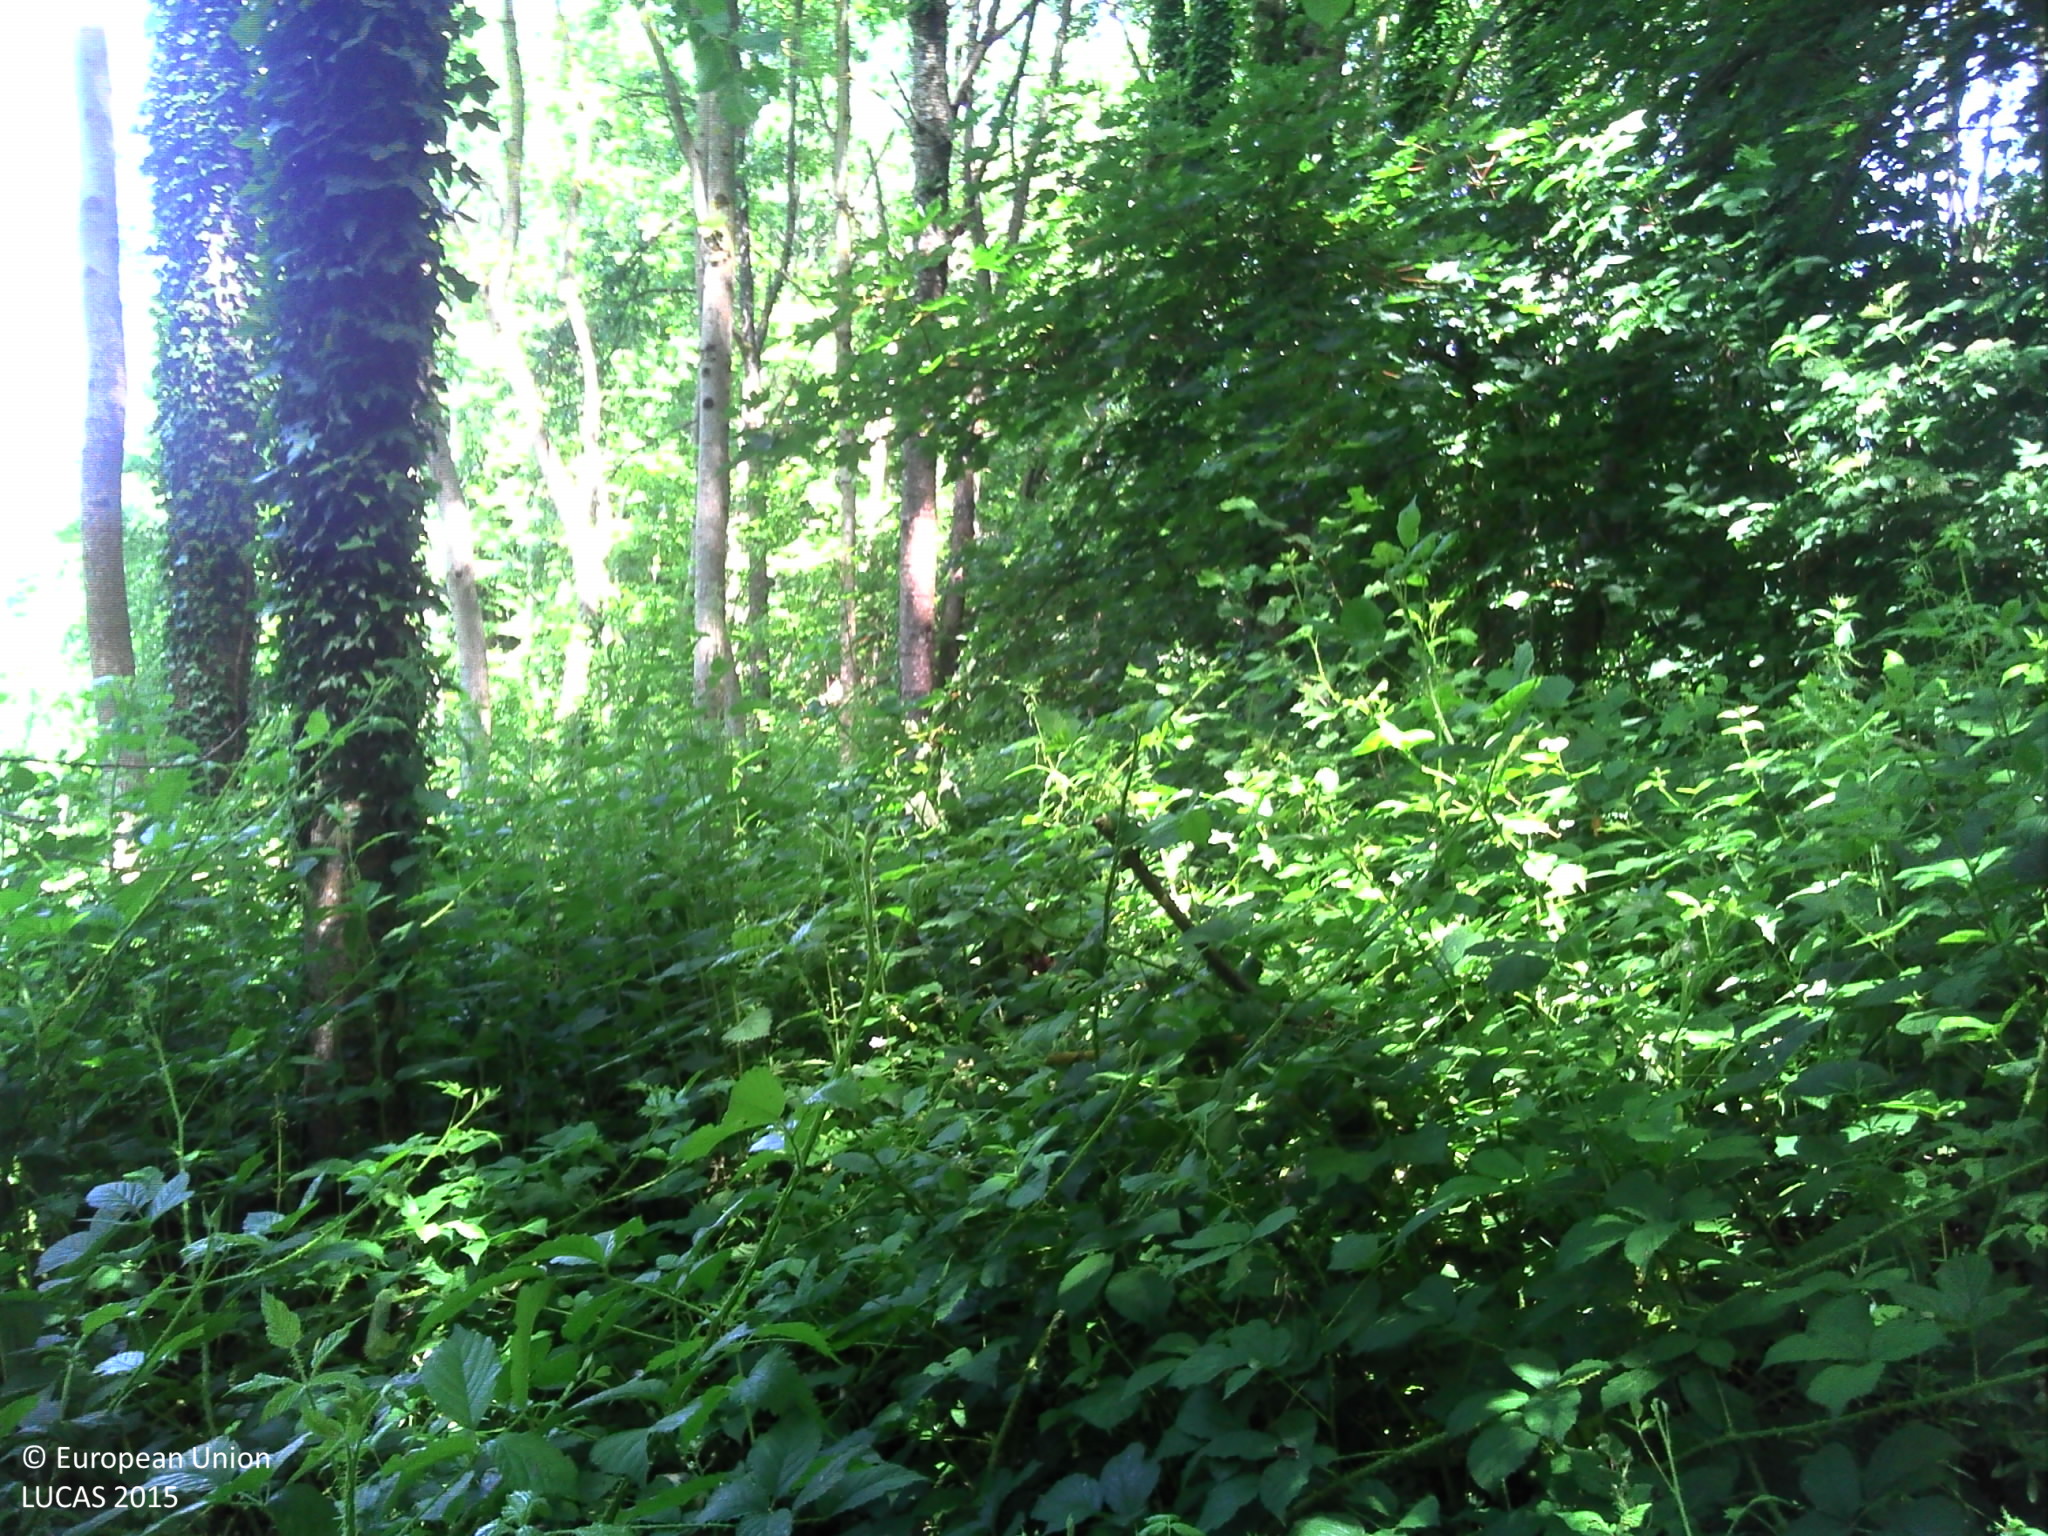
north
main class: Woodland
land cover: Other mixed woodland
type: hemiboreal forest and nemoral coniferous forest and mixed broadleaved-coniferous forest
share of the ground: > 75 %
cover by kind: broadleaved forest trees 55 %, coniferous forest trees 25 %, shrubs 15 %, lichens and mosses 5 %
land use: Semi-natural and natural areas not in use
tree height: > 5 m
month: June
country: FR
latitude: 48.6075
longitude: -0.1352
